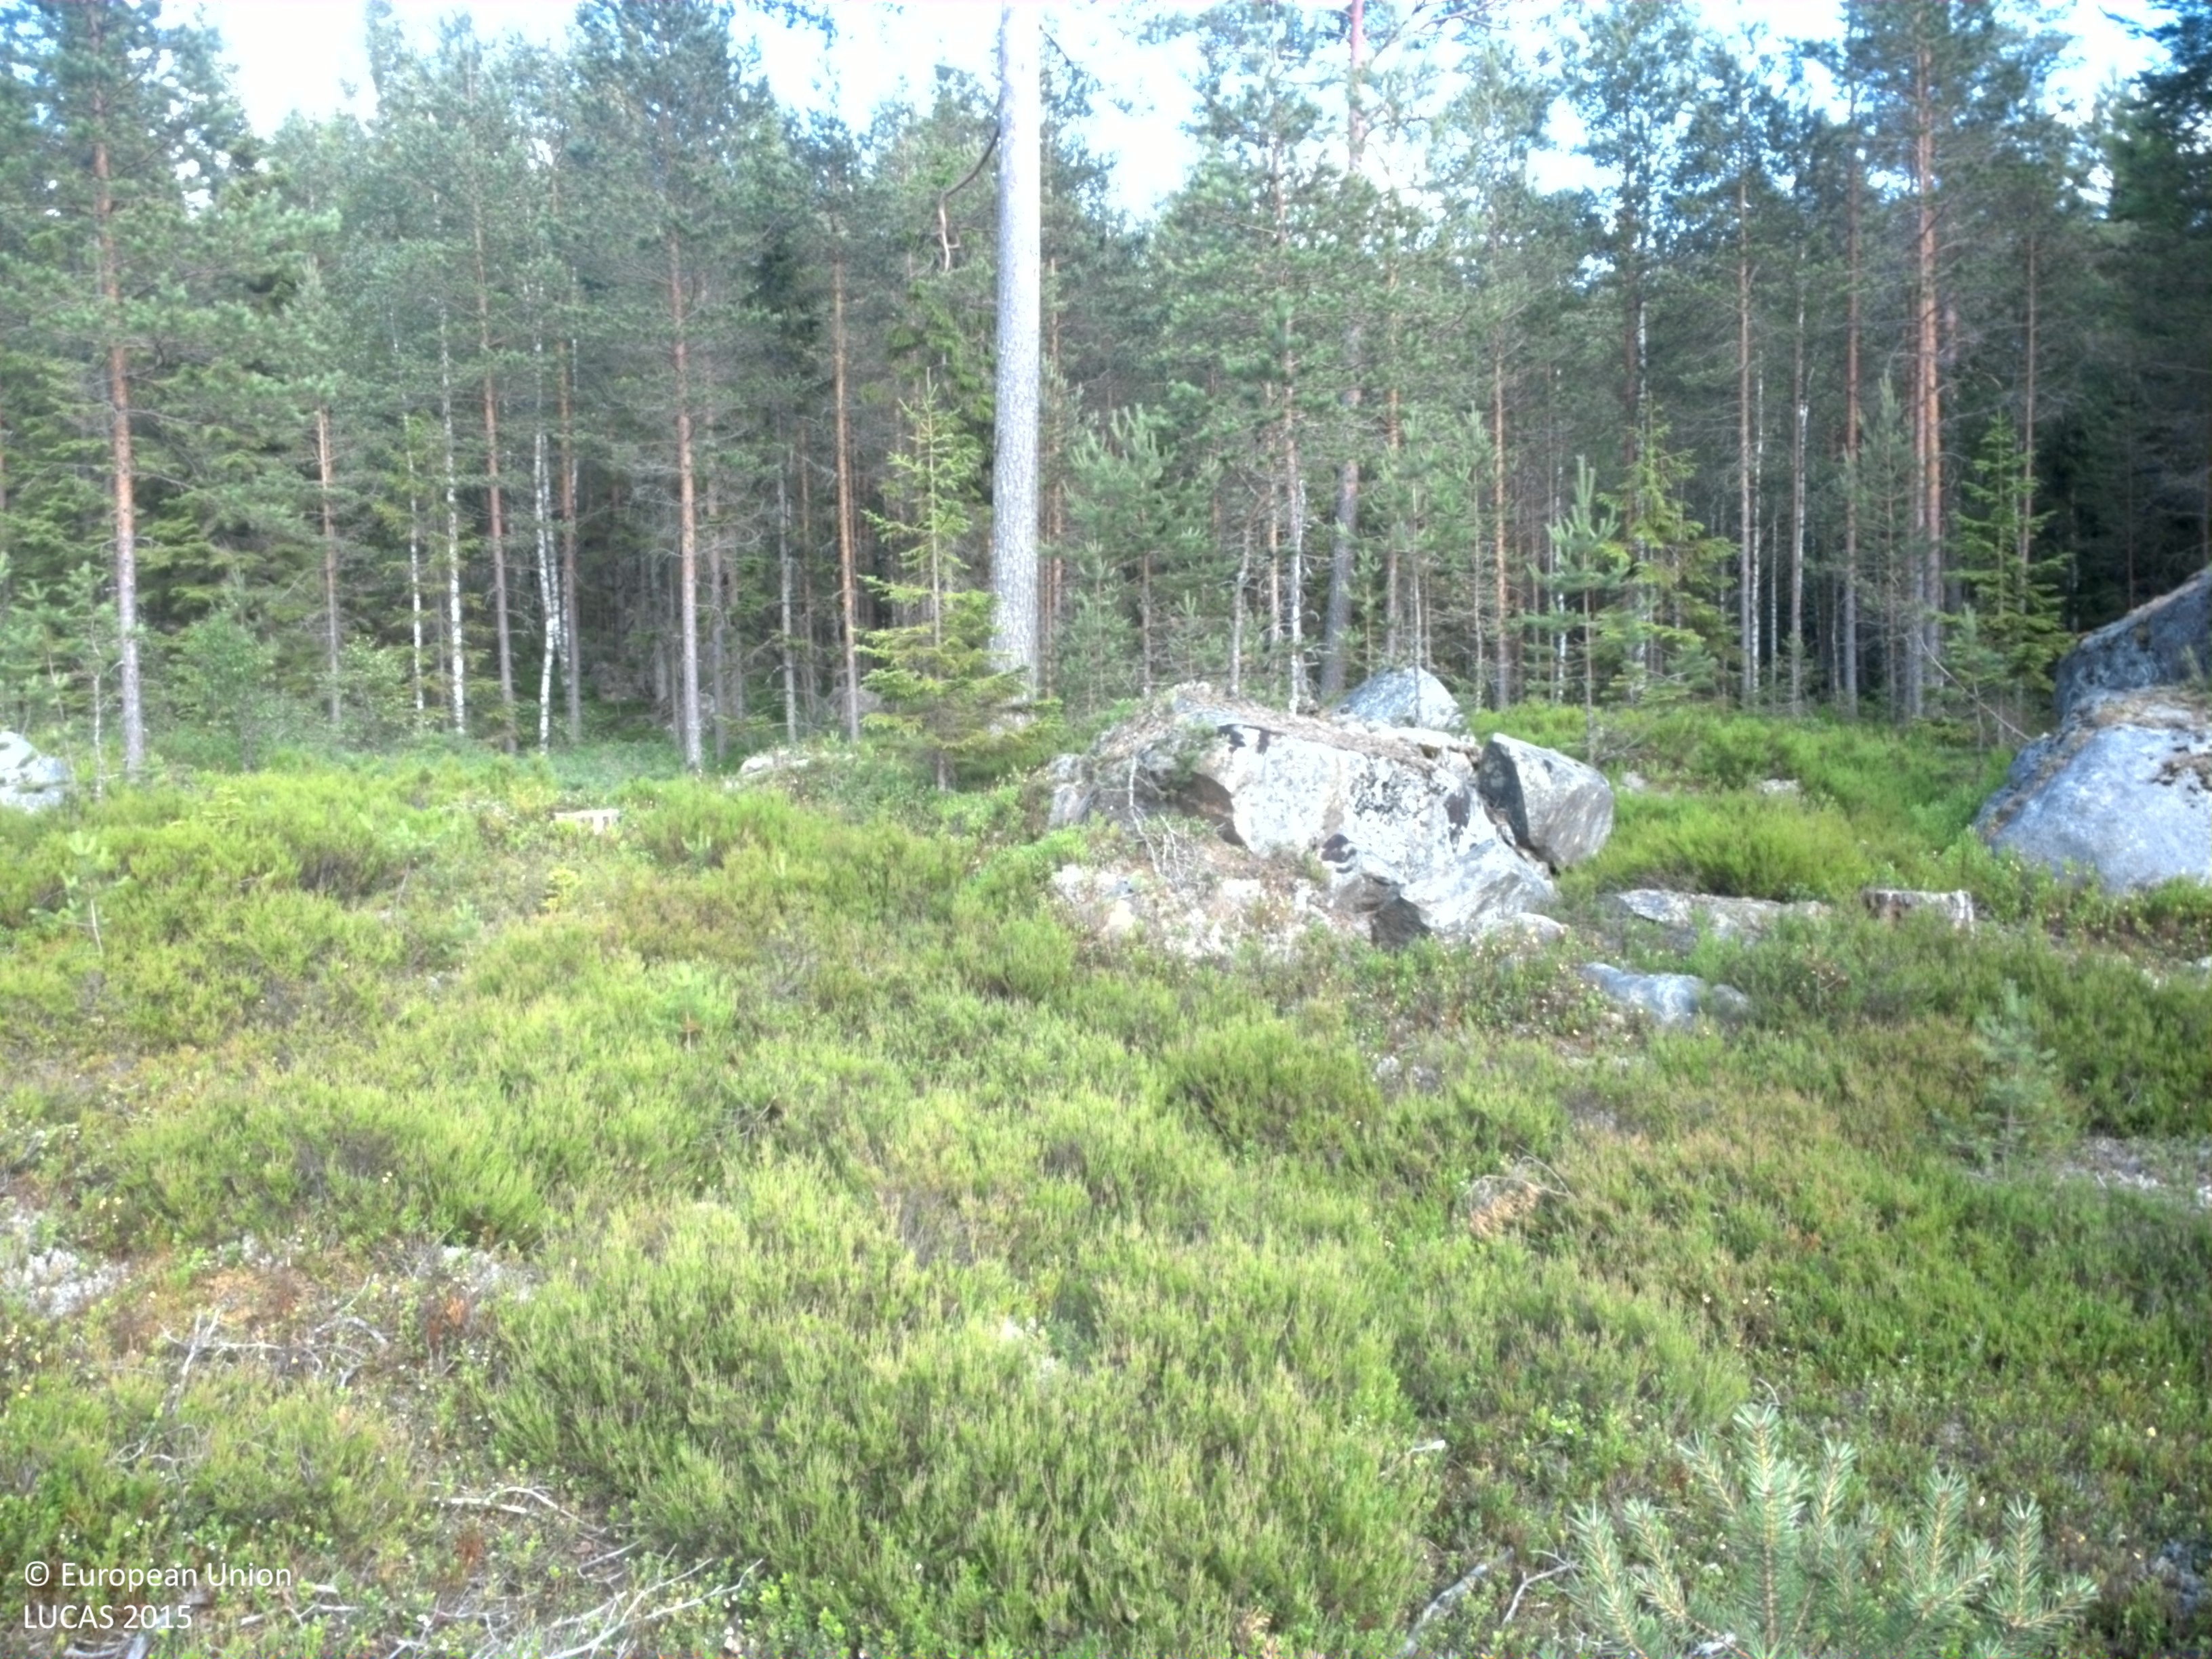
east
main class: Woodland
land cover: Pine dominated coniferous woodland
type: boreal forest
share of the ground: 25 - 50 %
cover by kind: coniferous forest trees 40 %, shrubs 35 %, lichens and mosses 10 %, consolidated bare surface 10 %, broadleaved forest trees 5 %
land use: Forestry
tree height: > 5 m
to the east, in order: Pine dominated coniferous woodland; Pine dominated mixed woodland; Spruce dominated mixed woodland; Inland fresh water bodies; Spruce dominated mixed woodland; Ponds and wetlands; Pine dominated mixed woodland; Pine dominated coniferous woodland
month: July
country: SE
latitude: 59.5597
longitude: 14.7508
